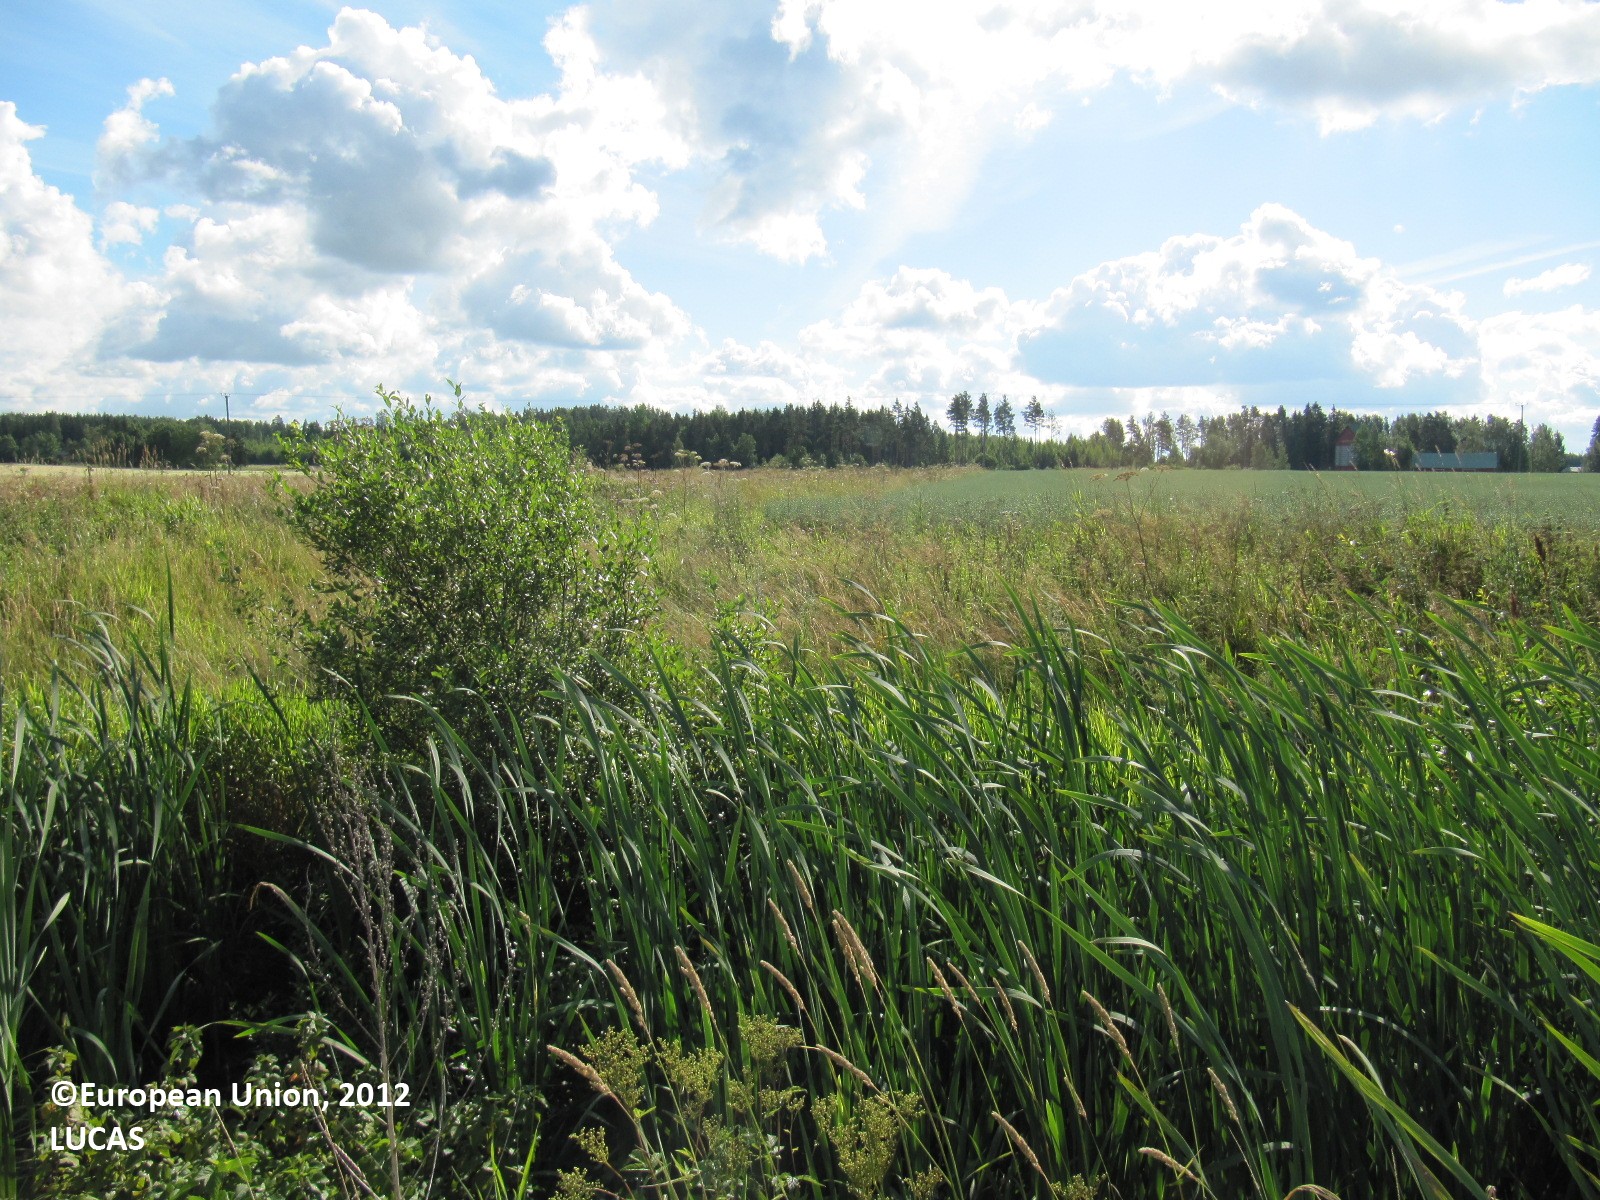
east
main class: Grassland
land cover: Spontaneously vegetated surfaces
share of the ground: > 75 %
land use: Fallow land
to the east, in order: Spontaneously vegetated surfaces; Electric lines; Ditches and canals; Arable land (only in case pi)
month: August
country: FI
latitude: 60.4751
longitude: 23.1606
